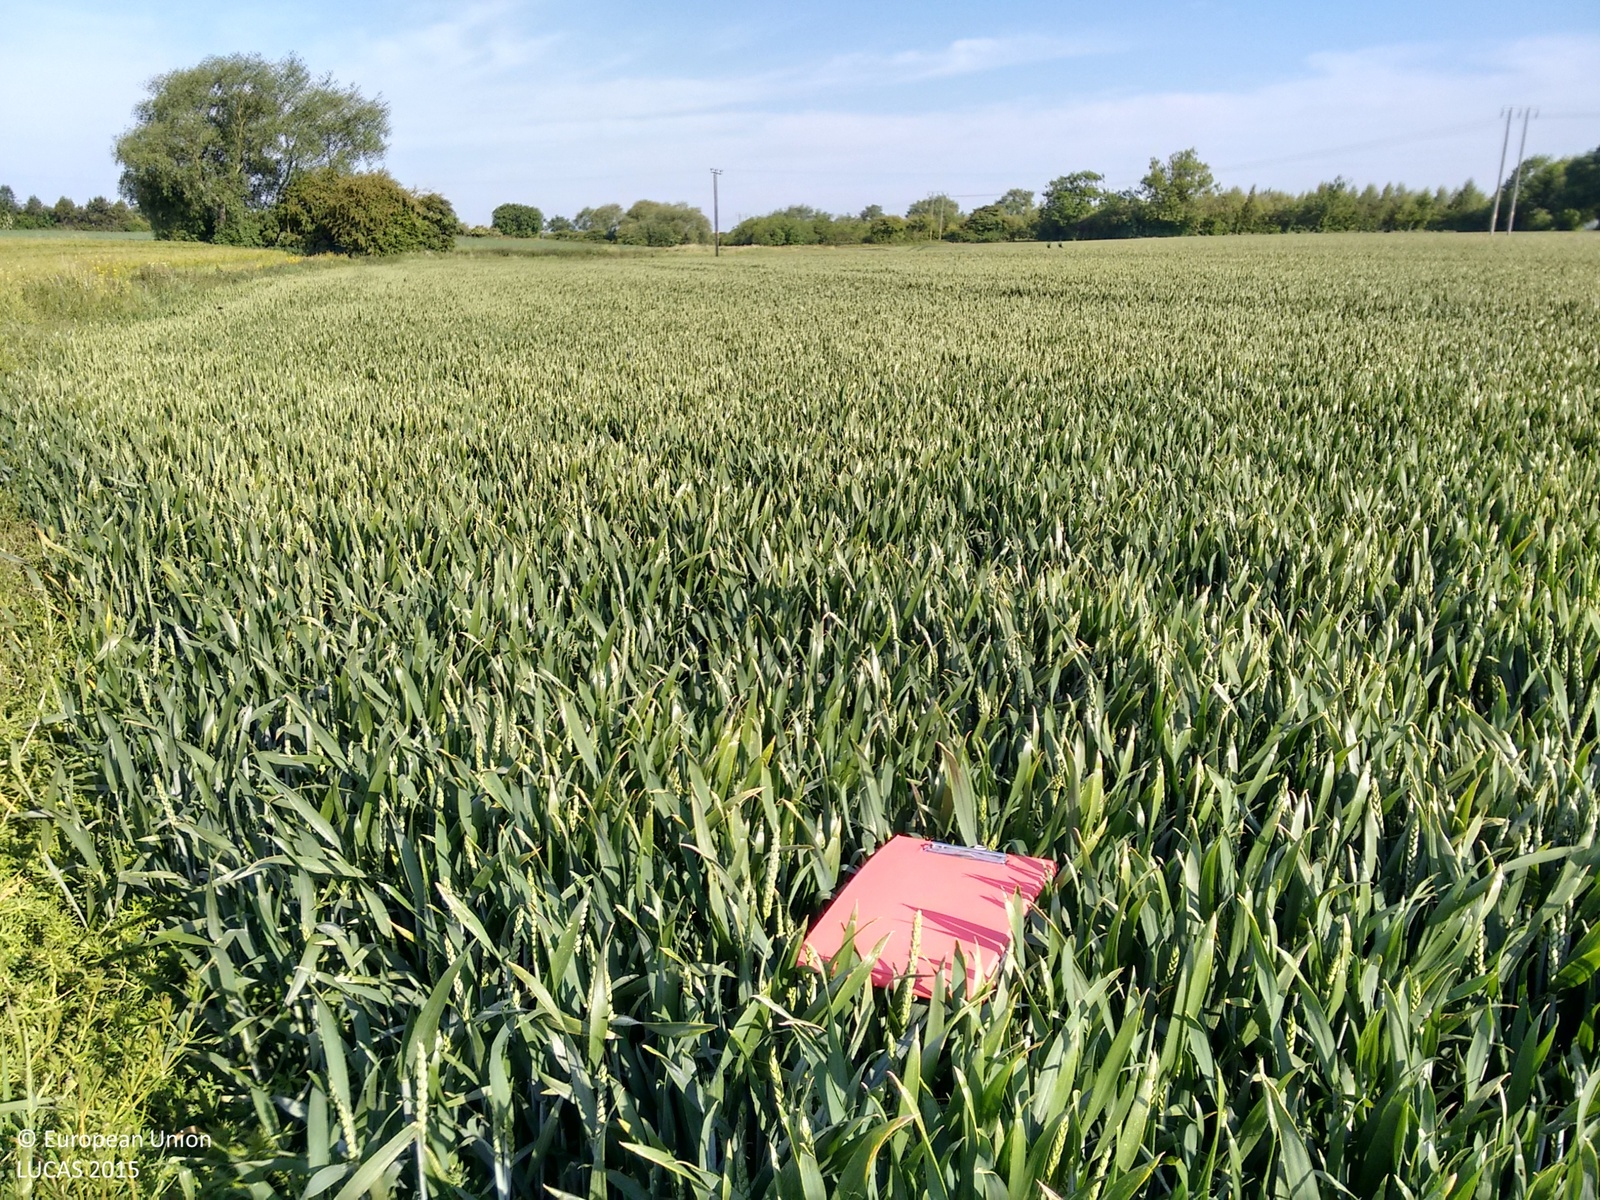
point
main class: Cropland
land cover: Common wheat
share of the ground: > 75 %
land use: Agriculture (excluding fallow land and kitchen gardens)
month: June
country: GB
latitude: 53.7993
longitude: -1.0818
